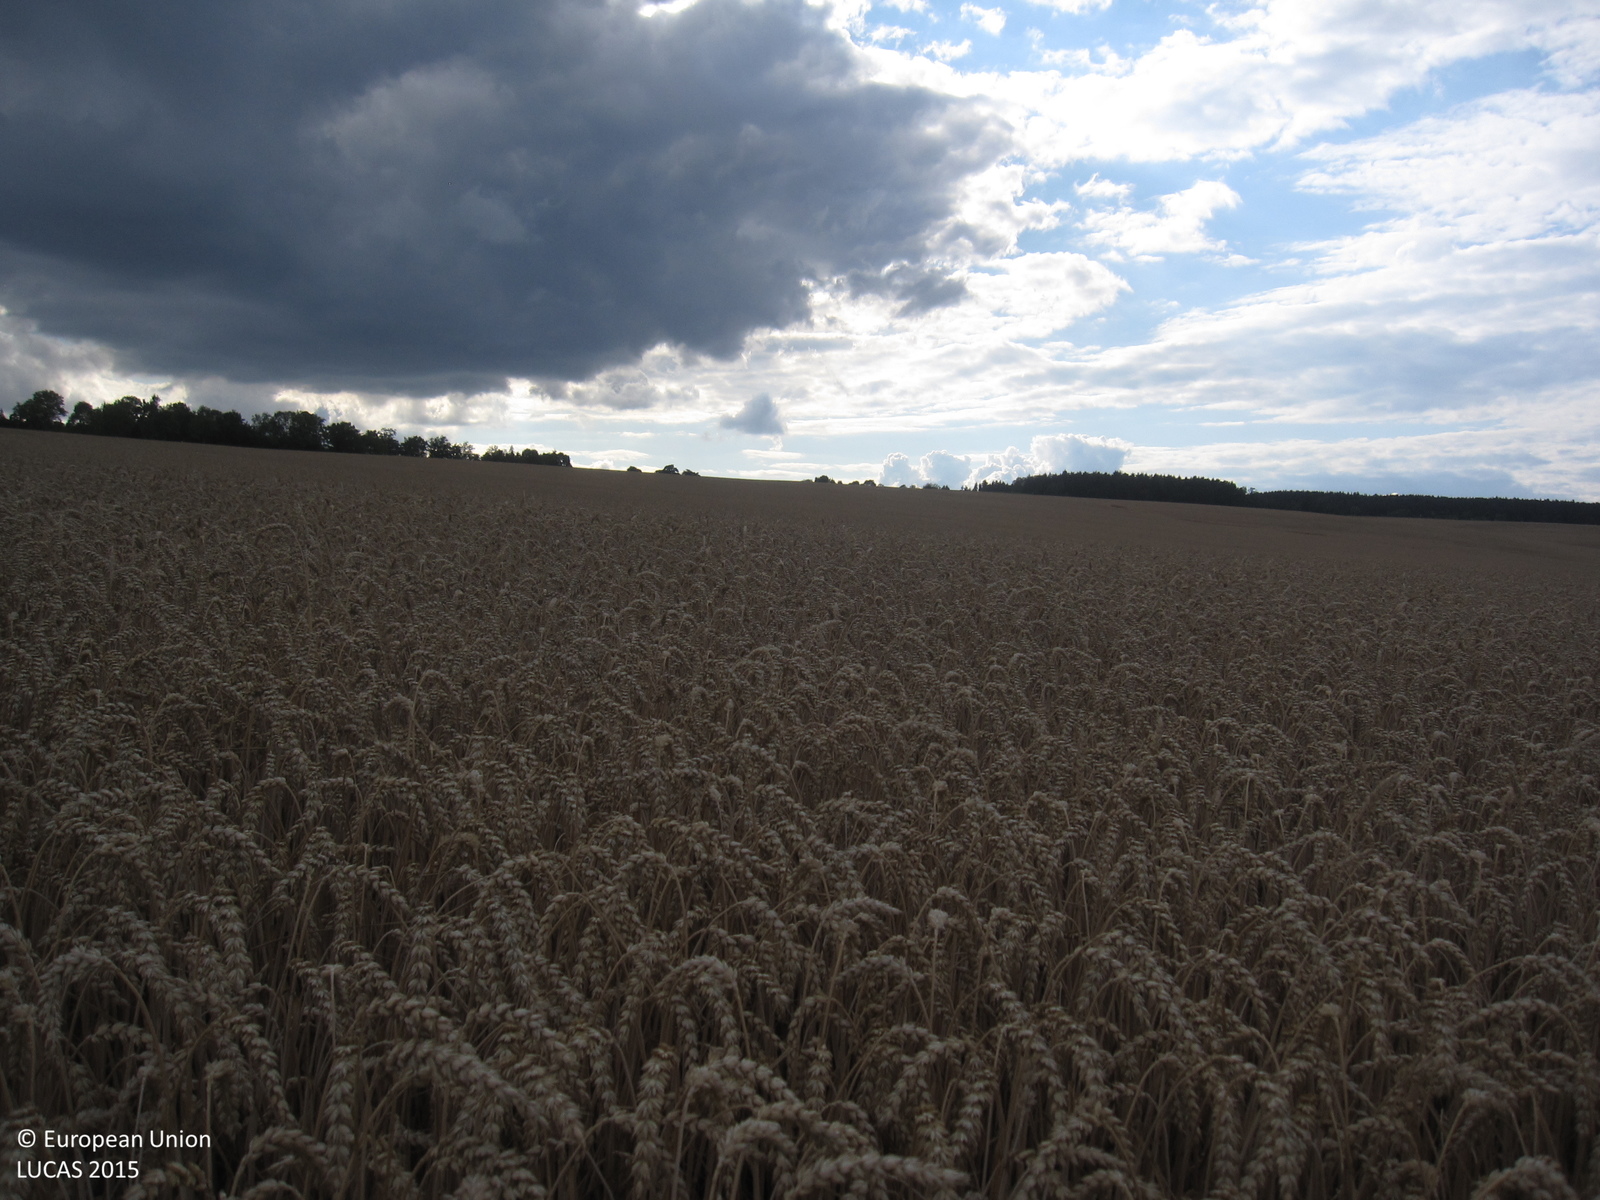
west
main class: Cropland
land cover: Common wheat
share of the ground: > 75 %
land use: Agriculture (excluding fallow land and kitchen gardens)
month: July
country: DE
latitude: 50.4727
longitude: 11.9863
